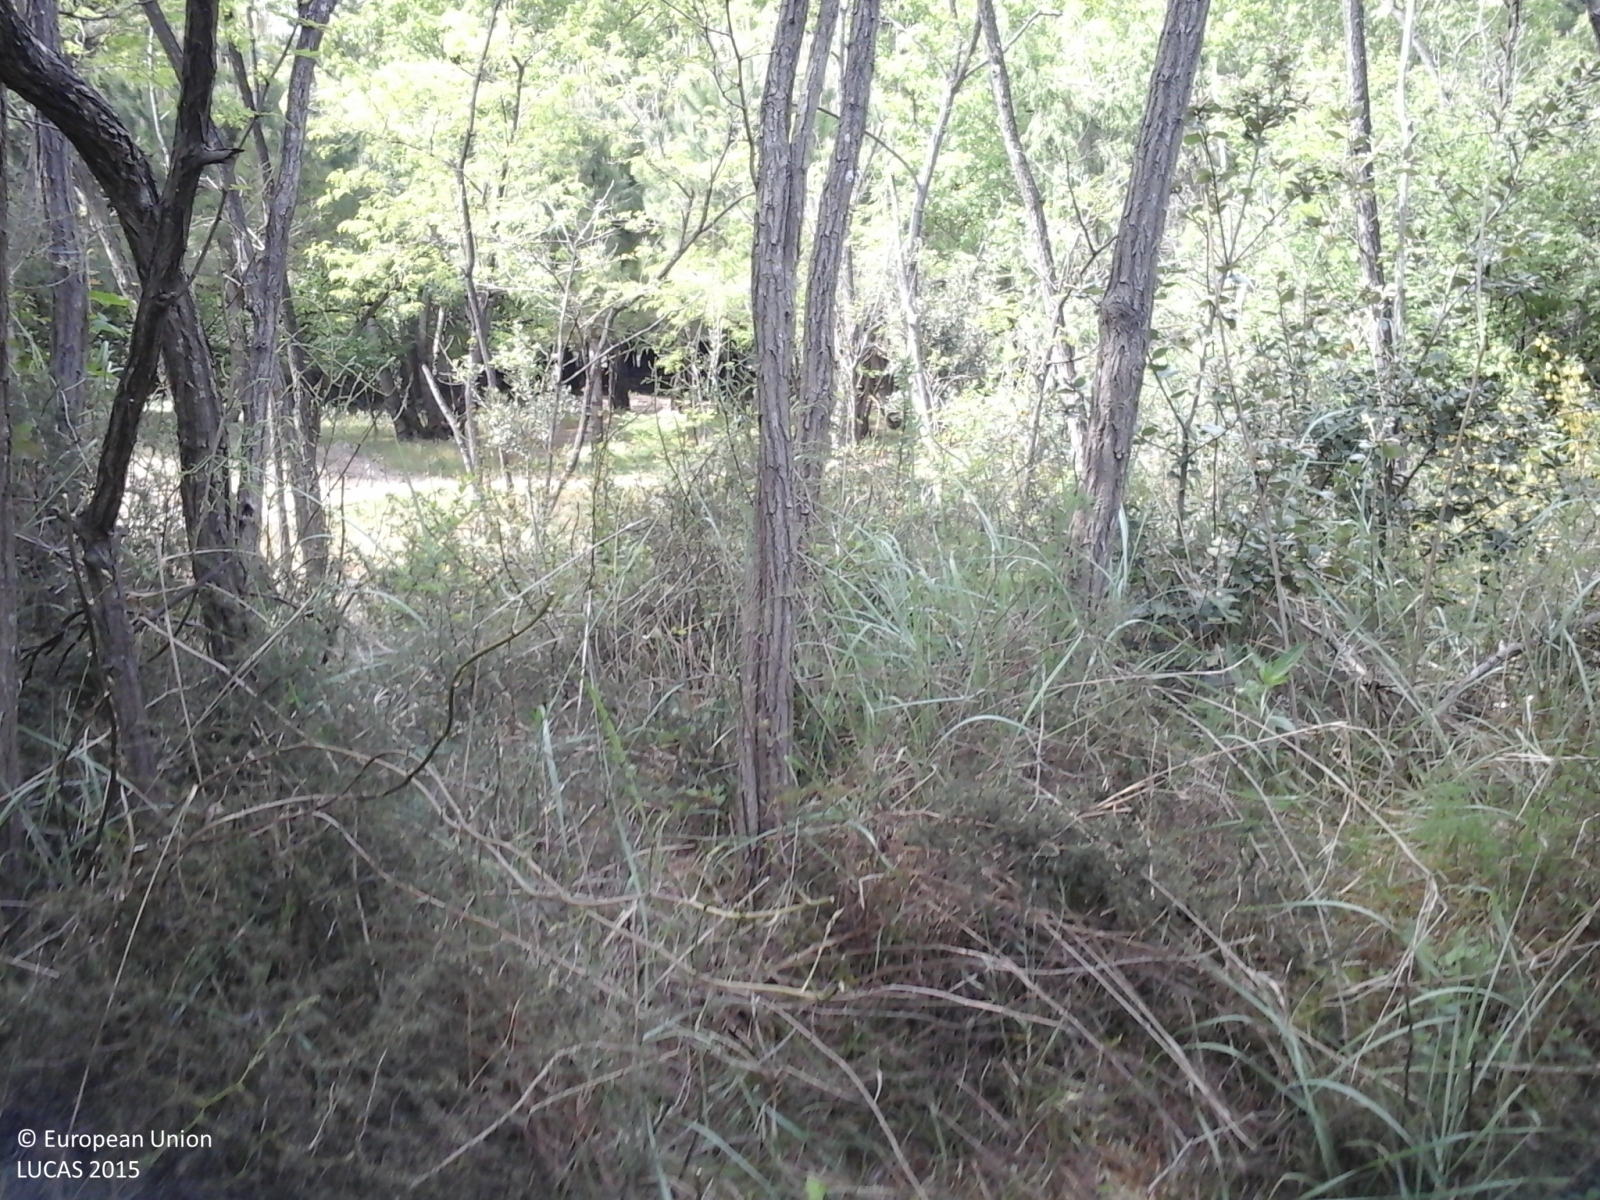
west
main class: Woodland
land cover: Pine dominated mixed woodland
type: coniferous forest of the mediterranean region
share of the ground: > 75 %
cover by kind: coniferous forest trees 40 %, broadleaved forest trees 20 %, shrubs 20 %, herbaceous plants 20 %
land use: Amenities, museums, leisure
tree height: > 5 m
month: May
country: IT
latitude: 45.5241
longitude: 12.6975
